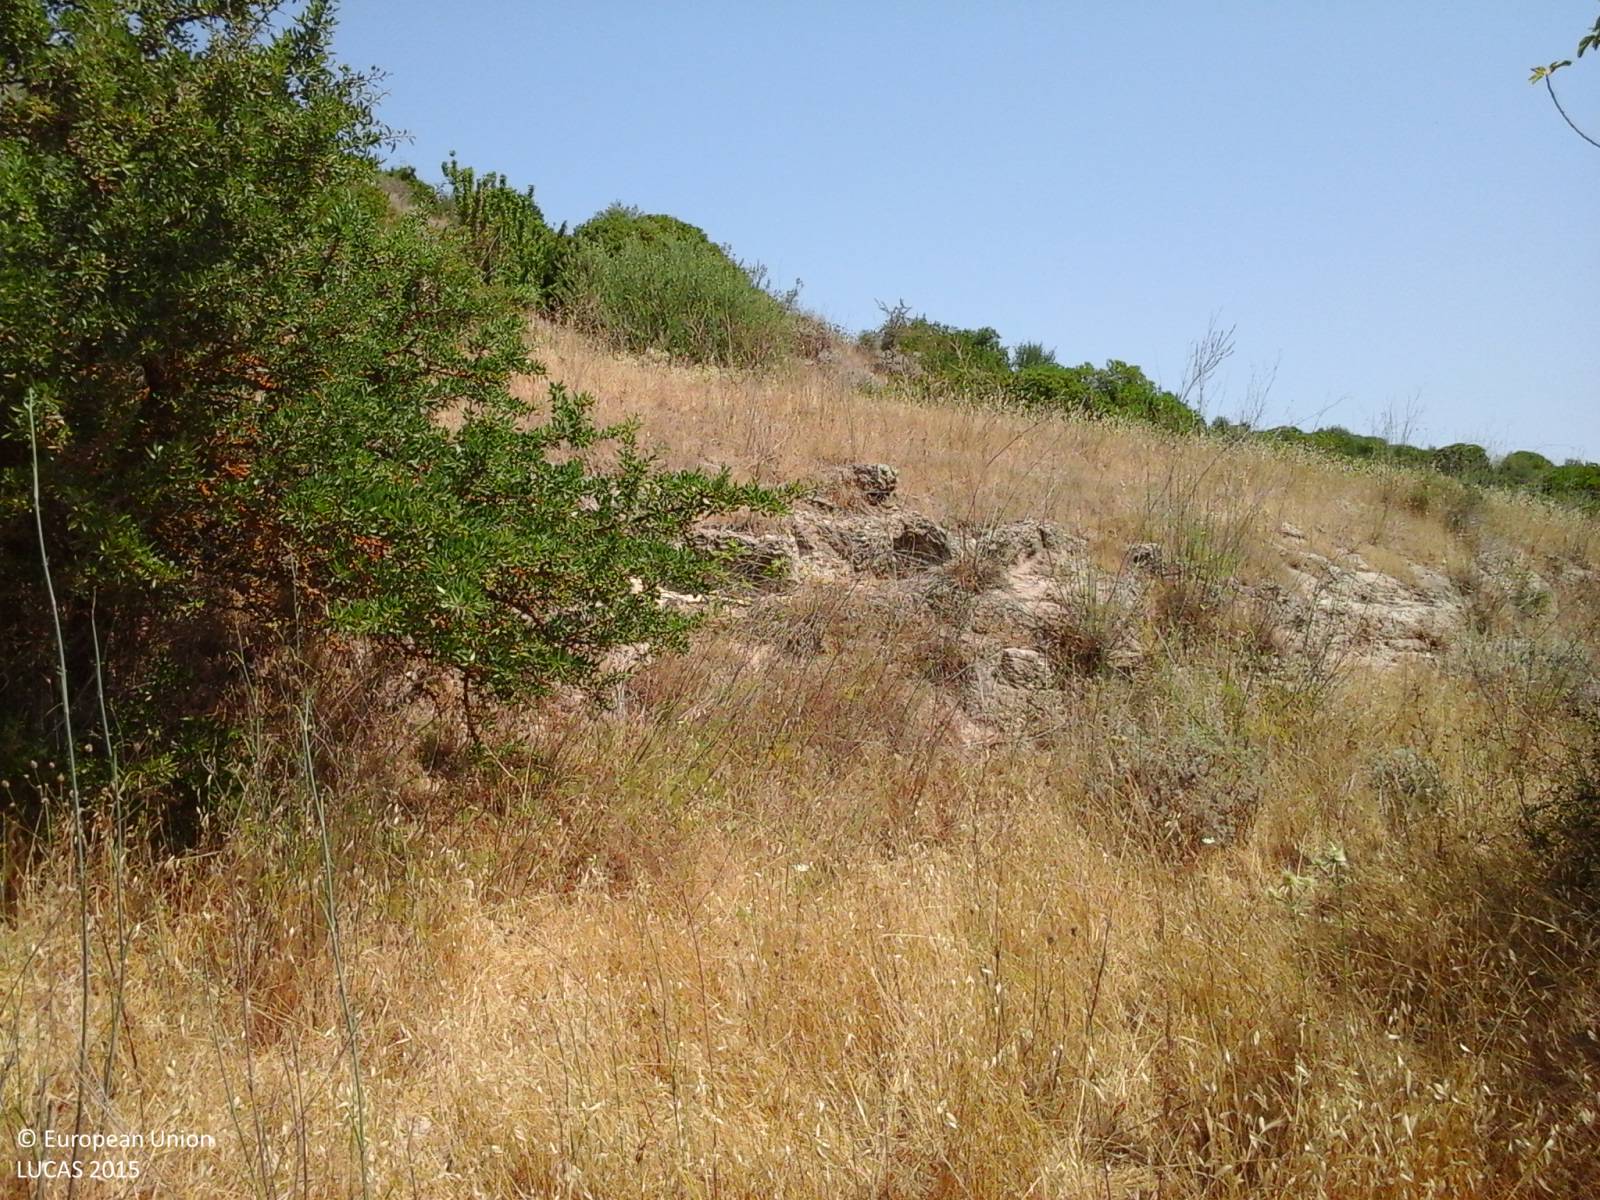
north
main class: Grassland
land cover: Grassland with sparse tree/shrub cover
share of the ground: > 75 %
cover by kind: herbaceous plants 80 %, shrubs 10 %, broadleaved forest trees 5 %, consolidated bare surface 5 %
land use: Agriculture (excluding fallow land and kitchen gardens)
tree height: < 5 m
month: July
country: IT
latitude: 40.8034
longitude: 8.8321
